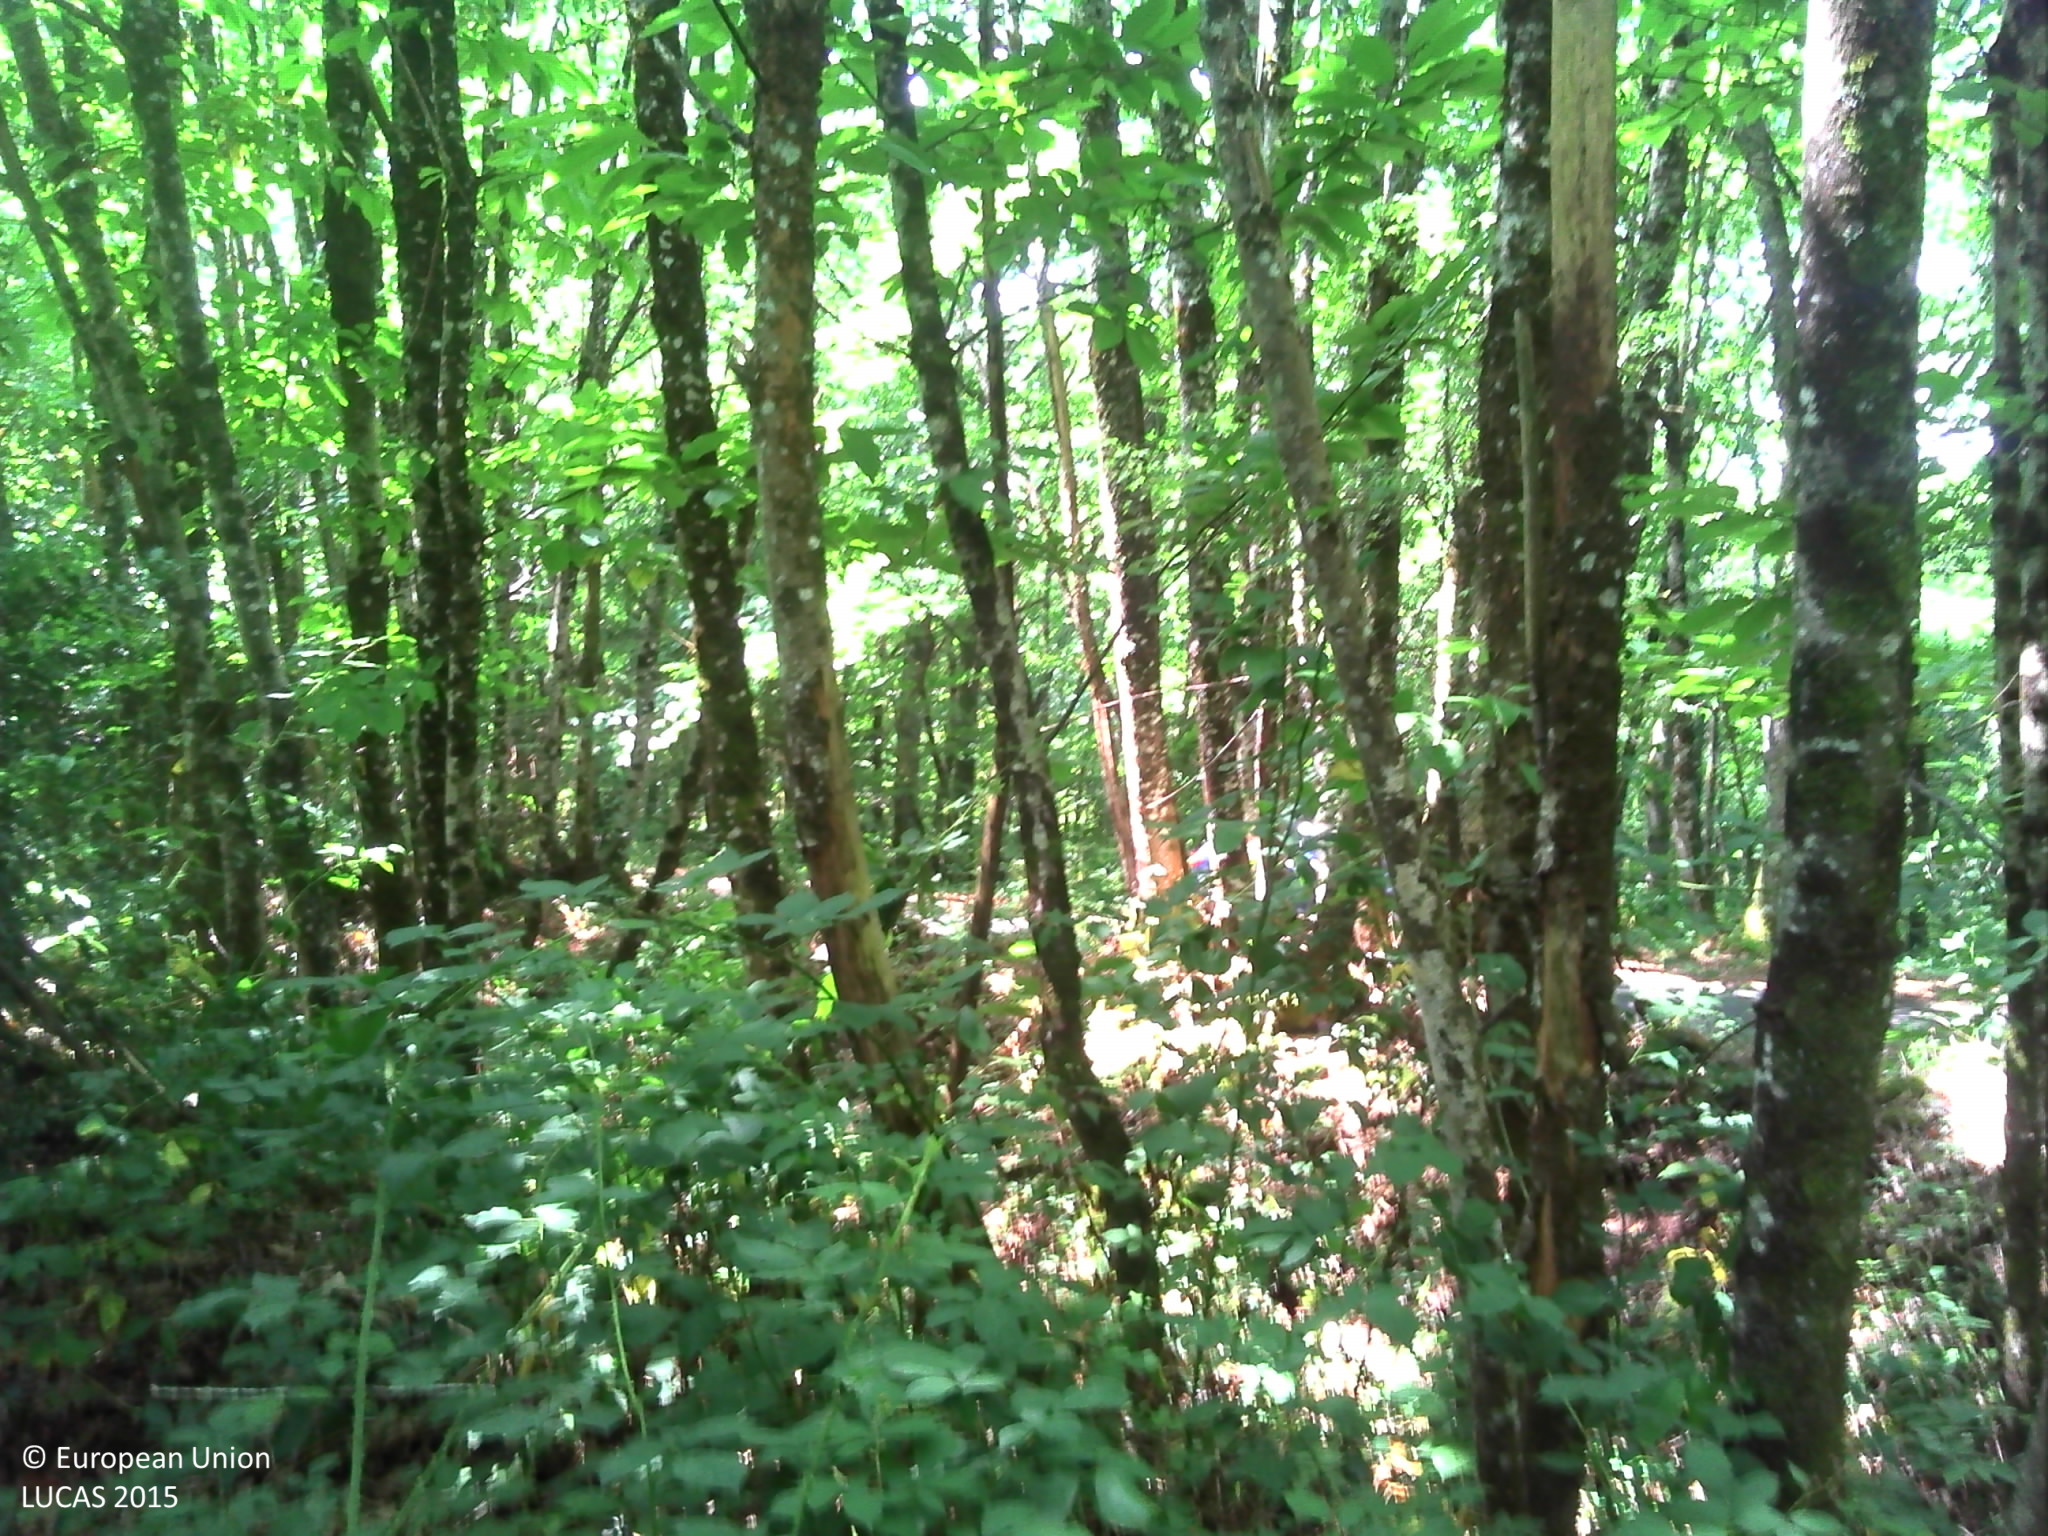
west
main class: Woodland
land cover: Broadleaved woodland
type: mesophytic deciduous forest
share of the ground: > 75 %
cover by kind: broadleaved forest trees 70 %, herbaceous plants 20 %, coniferous forest trees 10 %
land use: Abandoned areas
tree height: > 5 m
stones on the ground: < 10 %
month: August
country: FR
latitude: 46.0614
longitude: 1.2123
